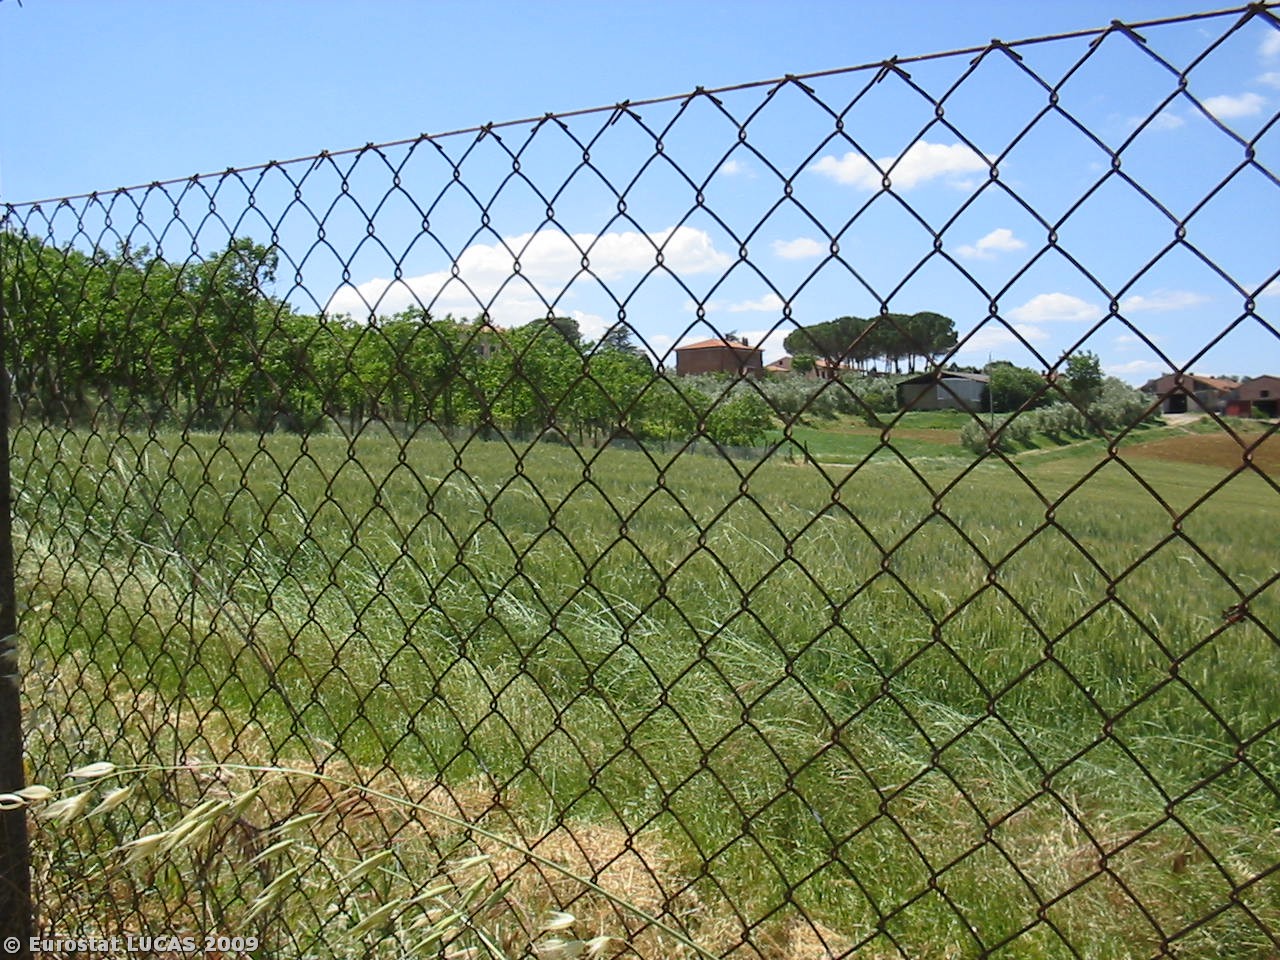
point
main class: Cropland
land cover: Common wheat
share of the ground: > 75 %
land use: Agriculture (excluding fallow land and kitchen gardens)
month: May
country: IT
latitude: 43.0859
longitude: 11.9963
